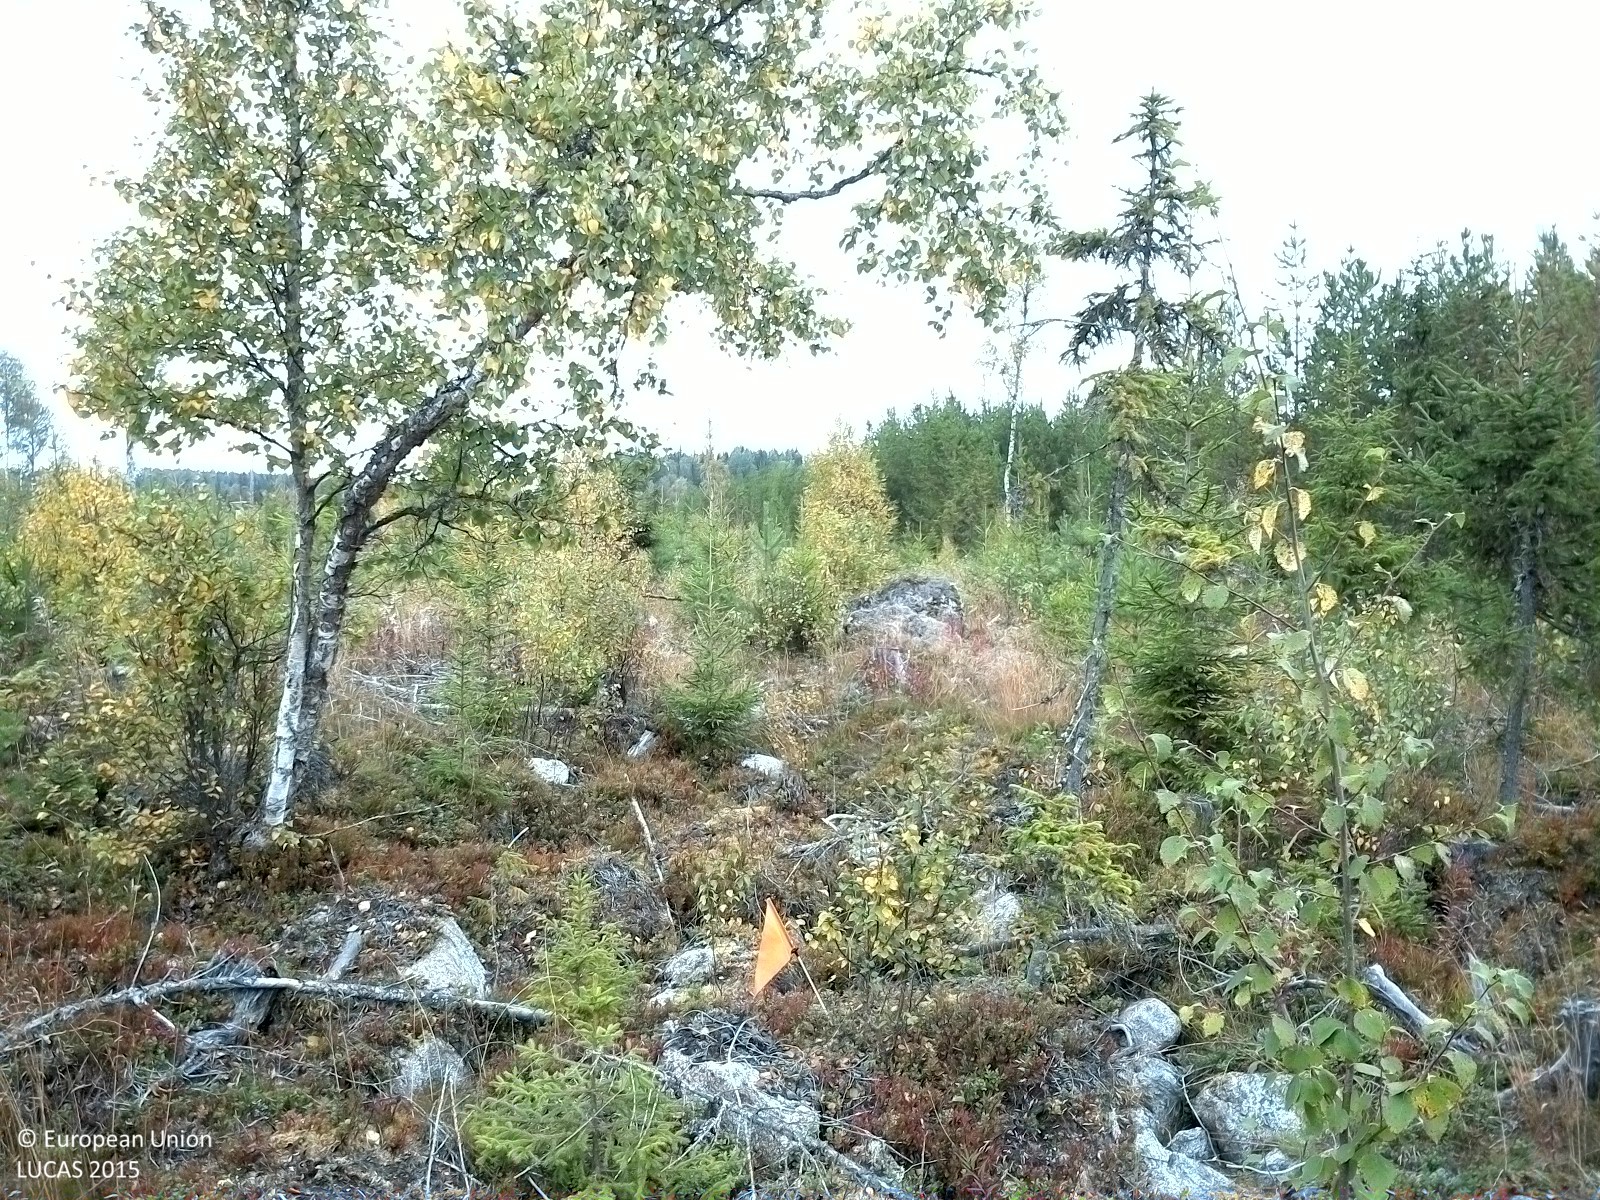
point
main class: Woodland
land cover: Spruce dominated mixed woodland
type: boreal forest
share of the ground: 25 - 50 %
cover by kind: broadleaved forest trees 30 %, shrubs 30 %, lichens and mosses 25 %, coniferous forest trees 15 %
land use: Forestry
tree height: < 5 m
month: September
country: SE
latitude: 62.5431
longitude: 16.5304
